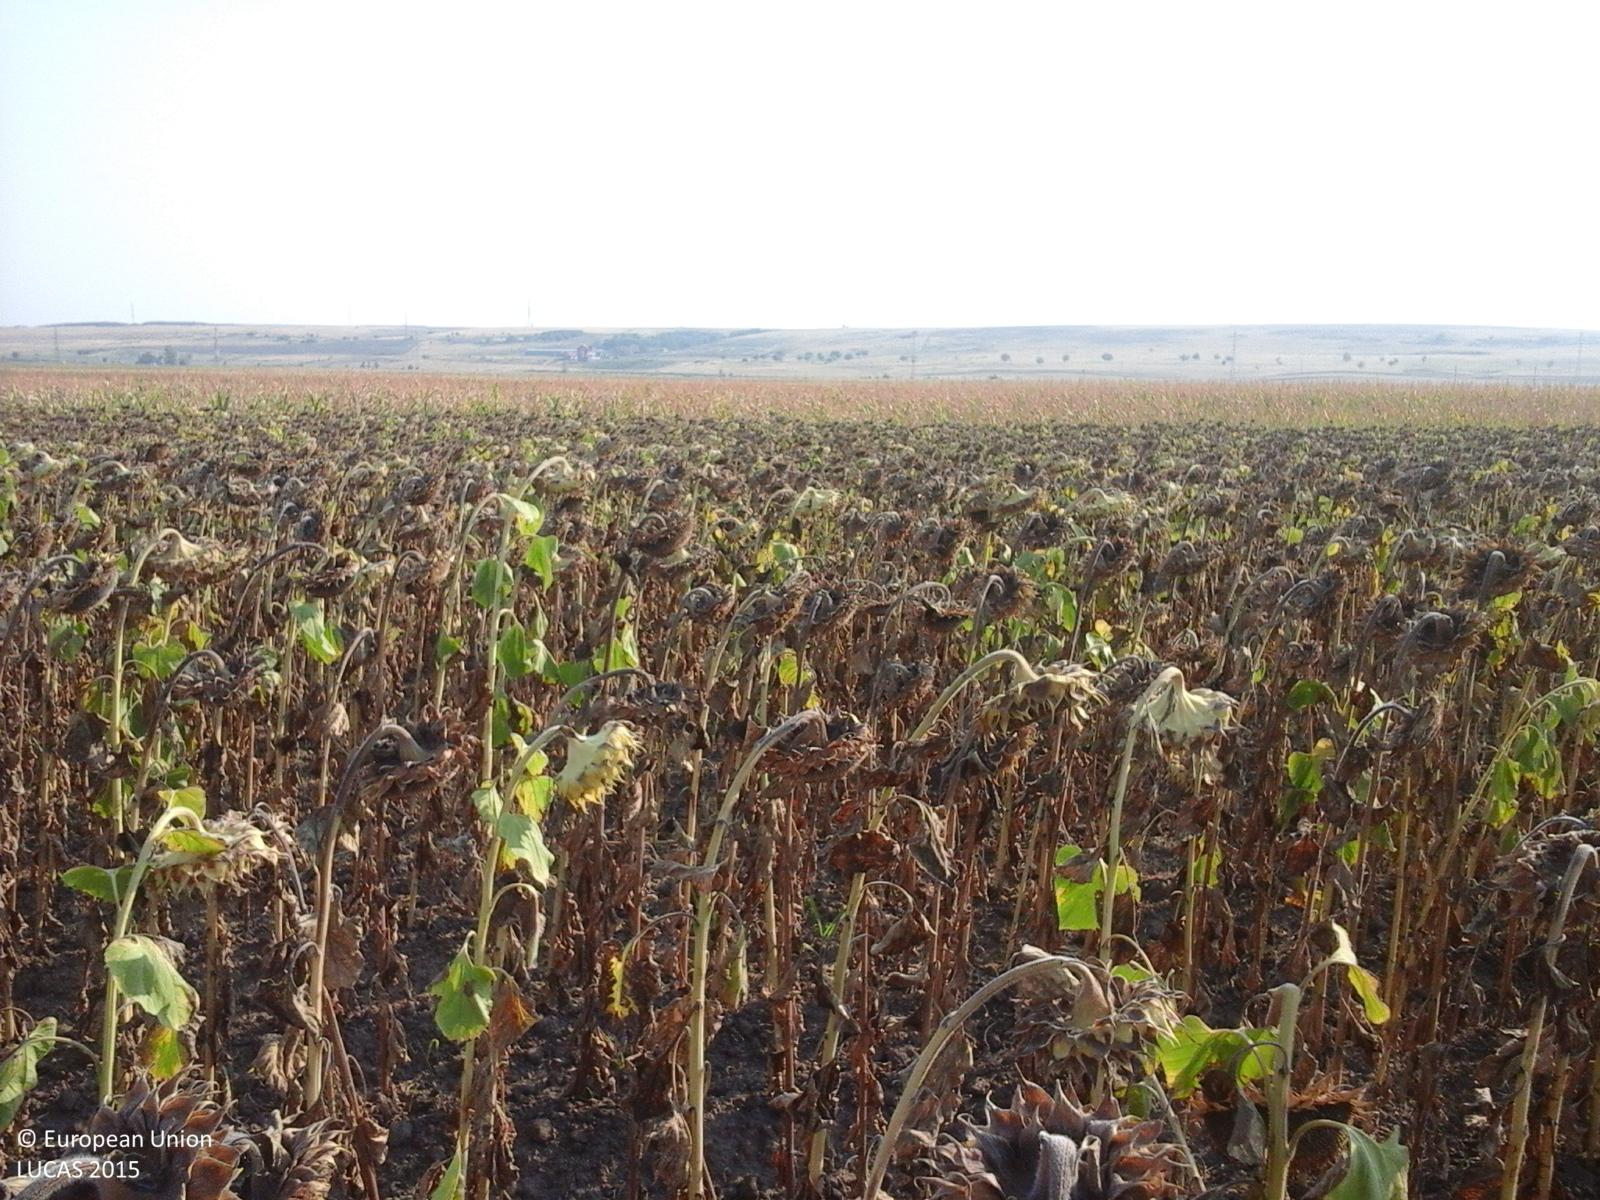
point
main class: Cropland
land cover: Sunflower
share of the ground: > 75 %
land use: Agriculture (excluding fallow land and kitchen gardens)
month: August
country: RO
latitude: 44.1338
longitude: 22.9787
